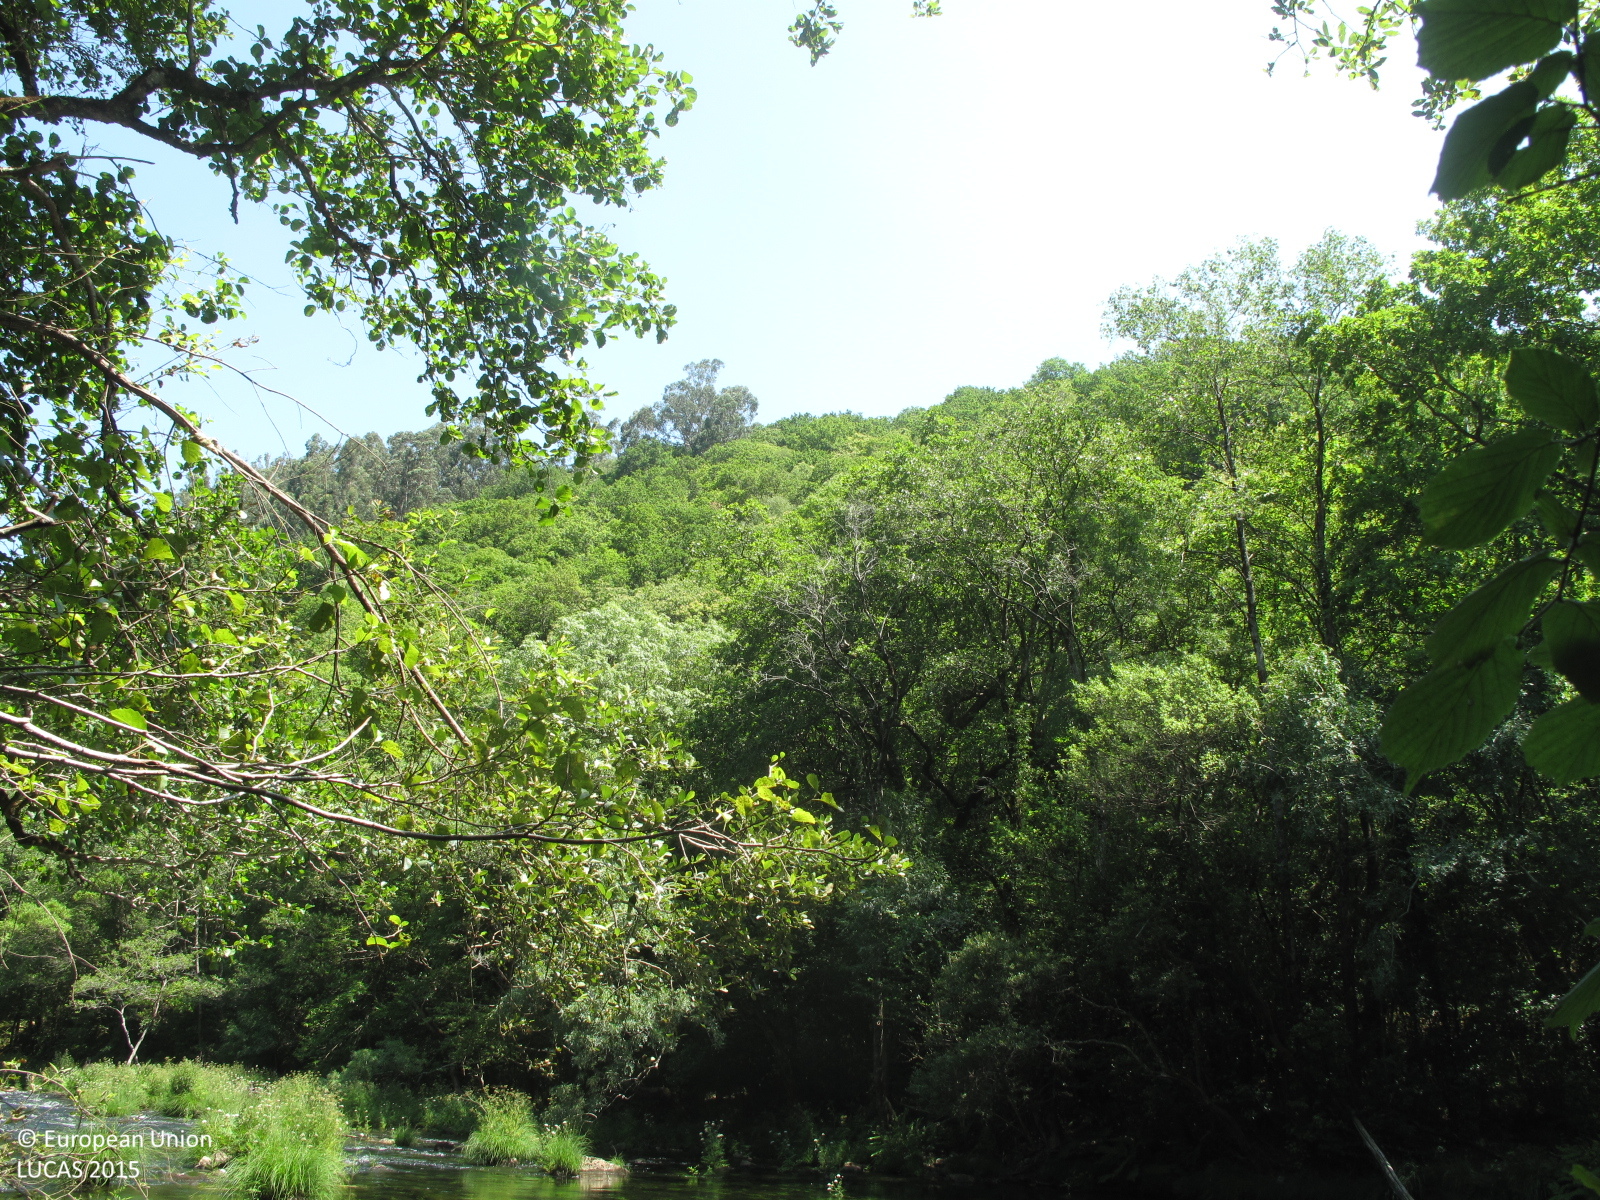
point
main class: Woodland
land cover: Broadleaved woodland
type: acidophilous oak and oak-birch forest
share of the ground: > 75 %
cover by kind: broadleaved forest trees 100 %
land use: Semi-natural and natural areas not in use
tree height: > 5 m
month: July
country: ES
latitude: 43.4085
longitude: -8.0899
